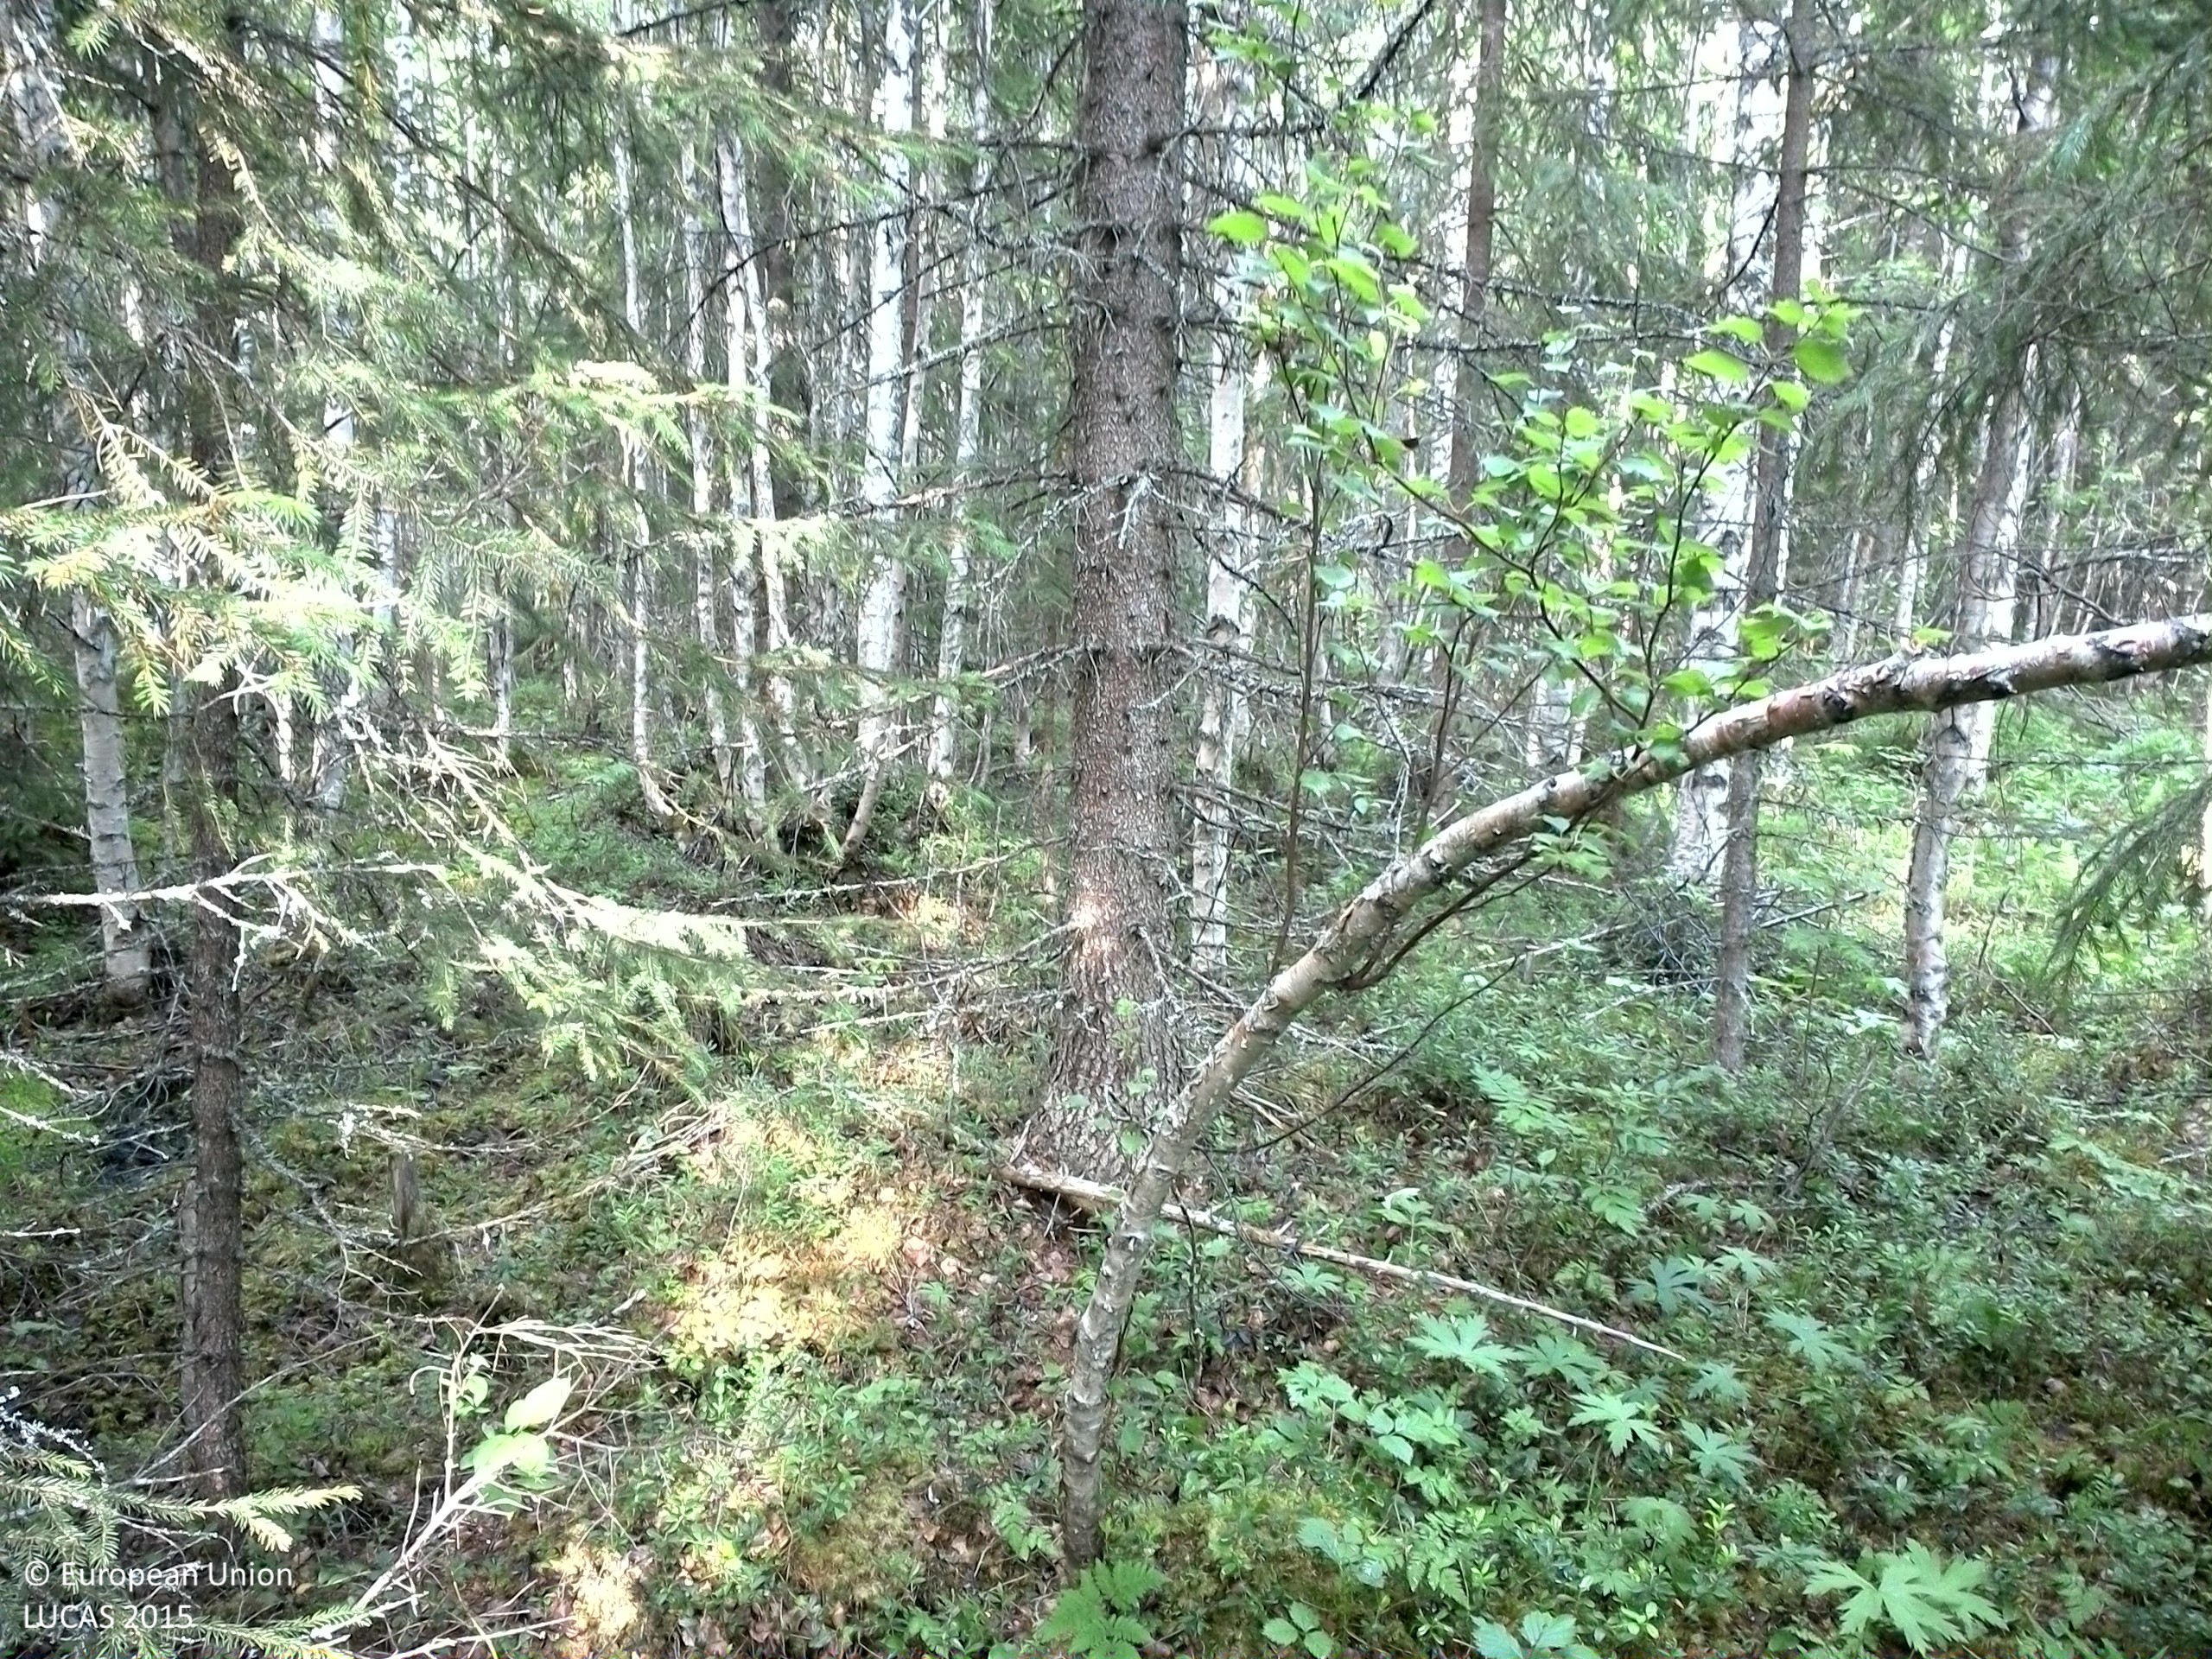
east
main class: Woodland
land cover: Spruce dominated mixed woodland
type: boreal forest
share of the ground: 50 - 75 %
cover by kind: coniferous forest trees 45 %, broadleaved forest trees 25 %, shrubs 10 %, herbaceous plants 10 %, lichens and mosses 10 %
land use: Forestry
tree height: > 5 m
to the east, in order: Spruce dominated mixed woodland; Pine dominated mixed woodland; Pine dominated coniferous woodland
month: August
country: SE
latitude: 63.5868
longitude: 16.6828
